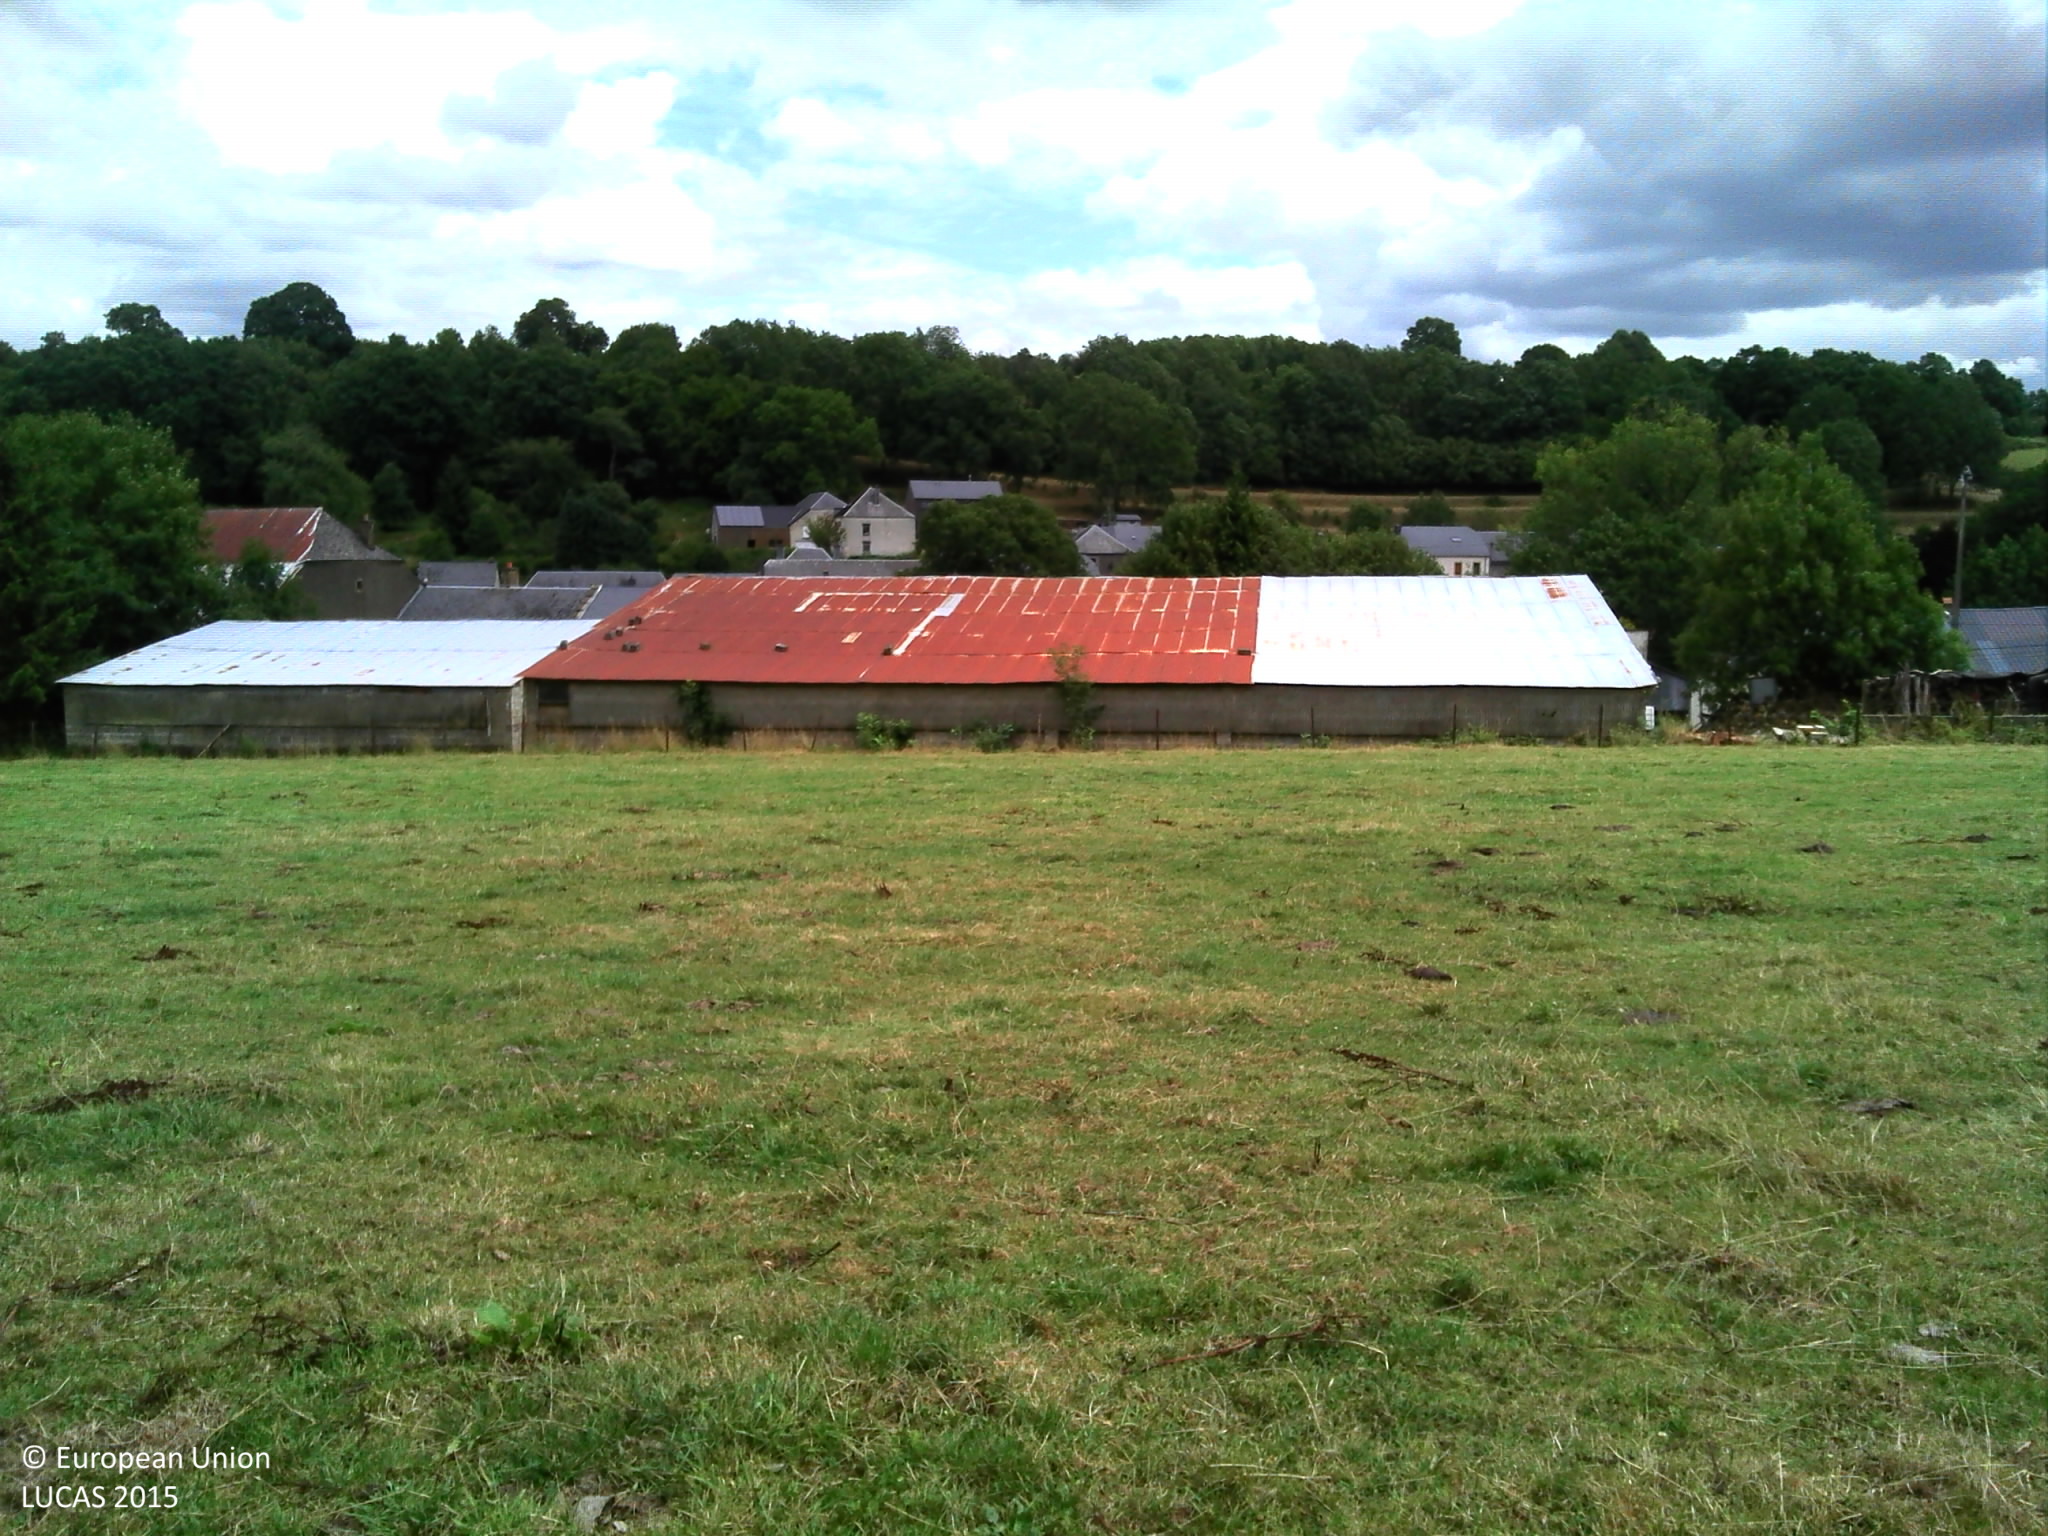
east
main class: Grassland
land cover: Grassland without tree/shrub cover
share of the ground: > 75 %
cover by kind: herbaceous plants 100 %
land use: Agriculture (excluding fallow land and kitchen gardens)
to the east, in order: Grassland without tree/shrub cover; Artificial constructions in urban areas; Grassland without tree/shrub cover; Rivers and streams; Abandoned hedges; Grassland without tree/shrub cover; Artificial constructions in urban areas
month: July
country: BE
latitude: 49.5808
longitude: 5.6974
